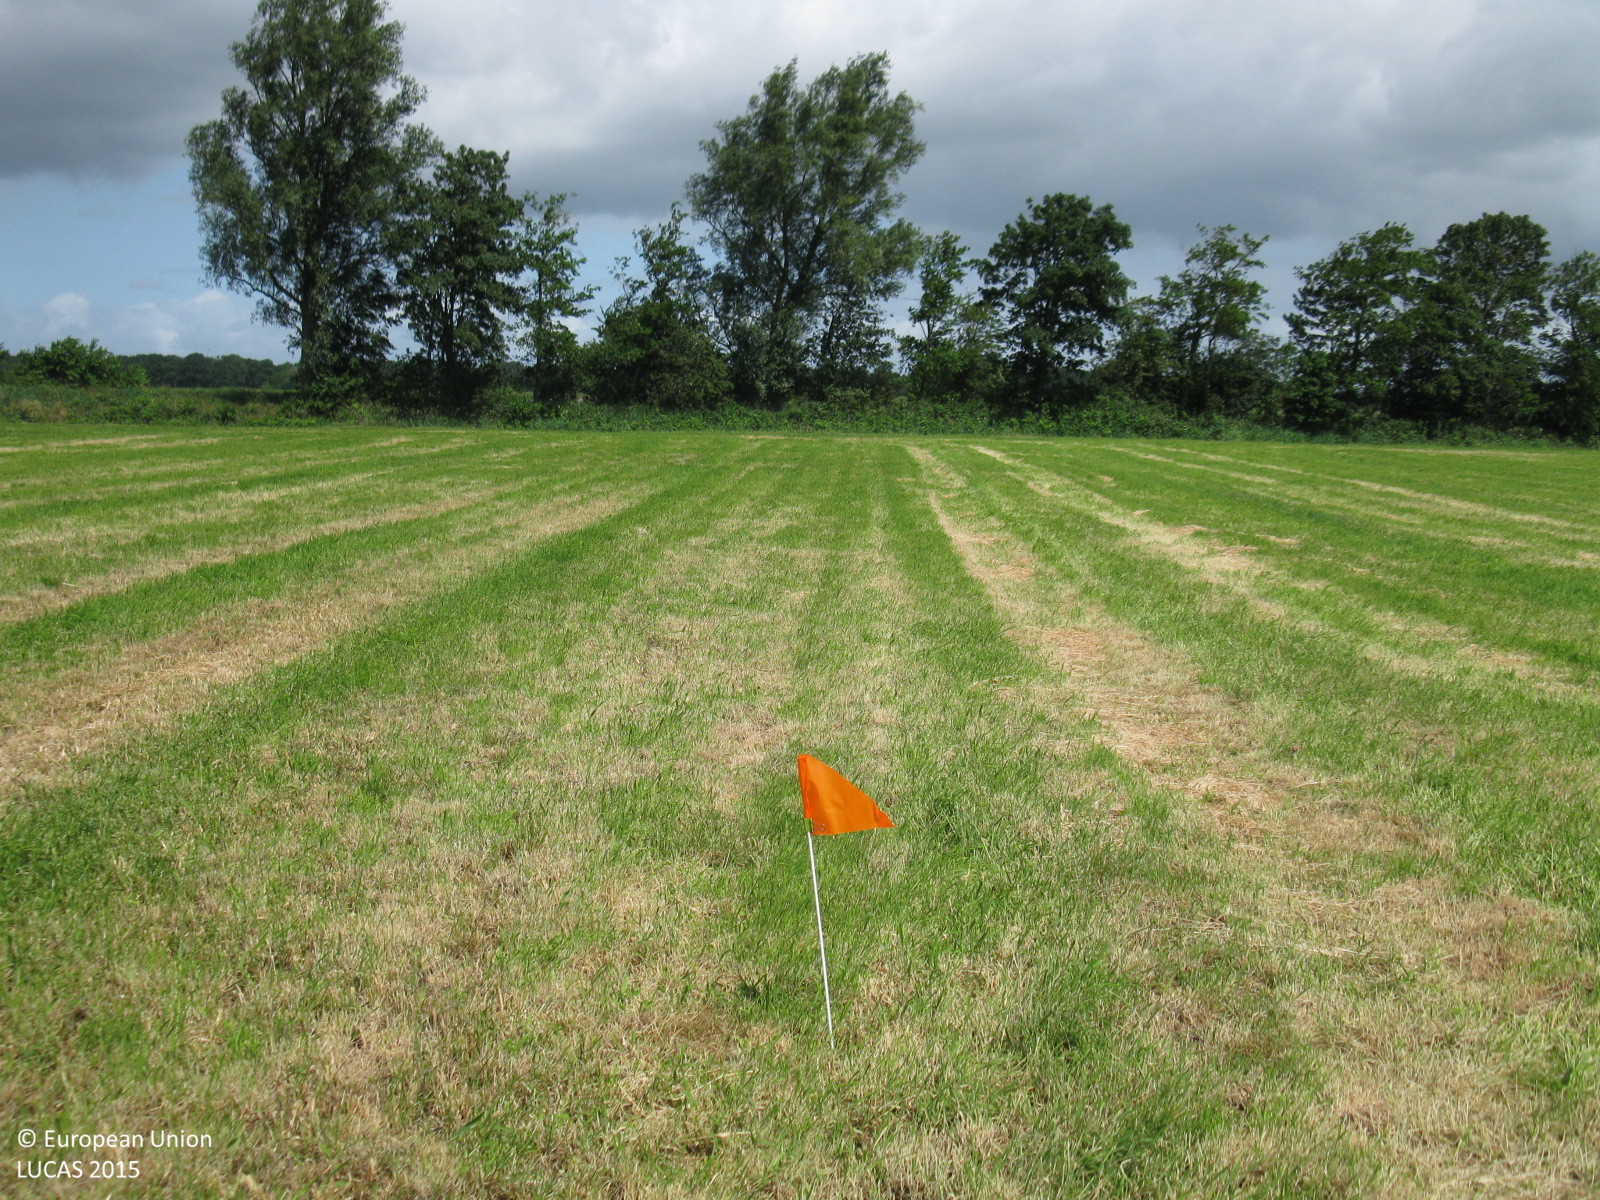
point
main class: Grassland
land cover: Grassland without tree/shrub cover
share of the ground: > 75 %
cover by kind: herbaceous plants 100 %
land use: Agriculture (excluding fallow land and kitchen gardens)
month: July
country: DE
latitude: 53.4732
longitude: 7.8764
